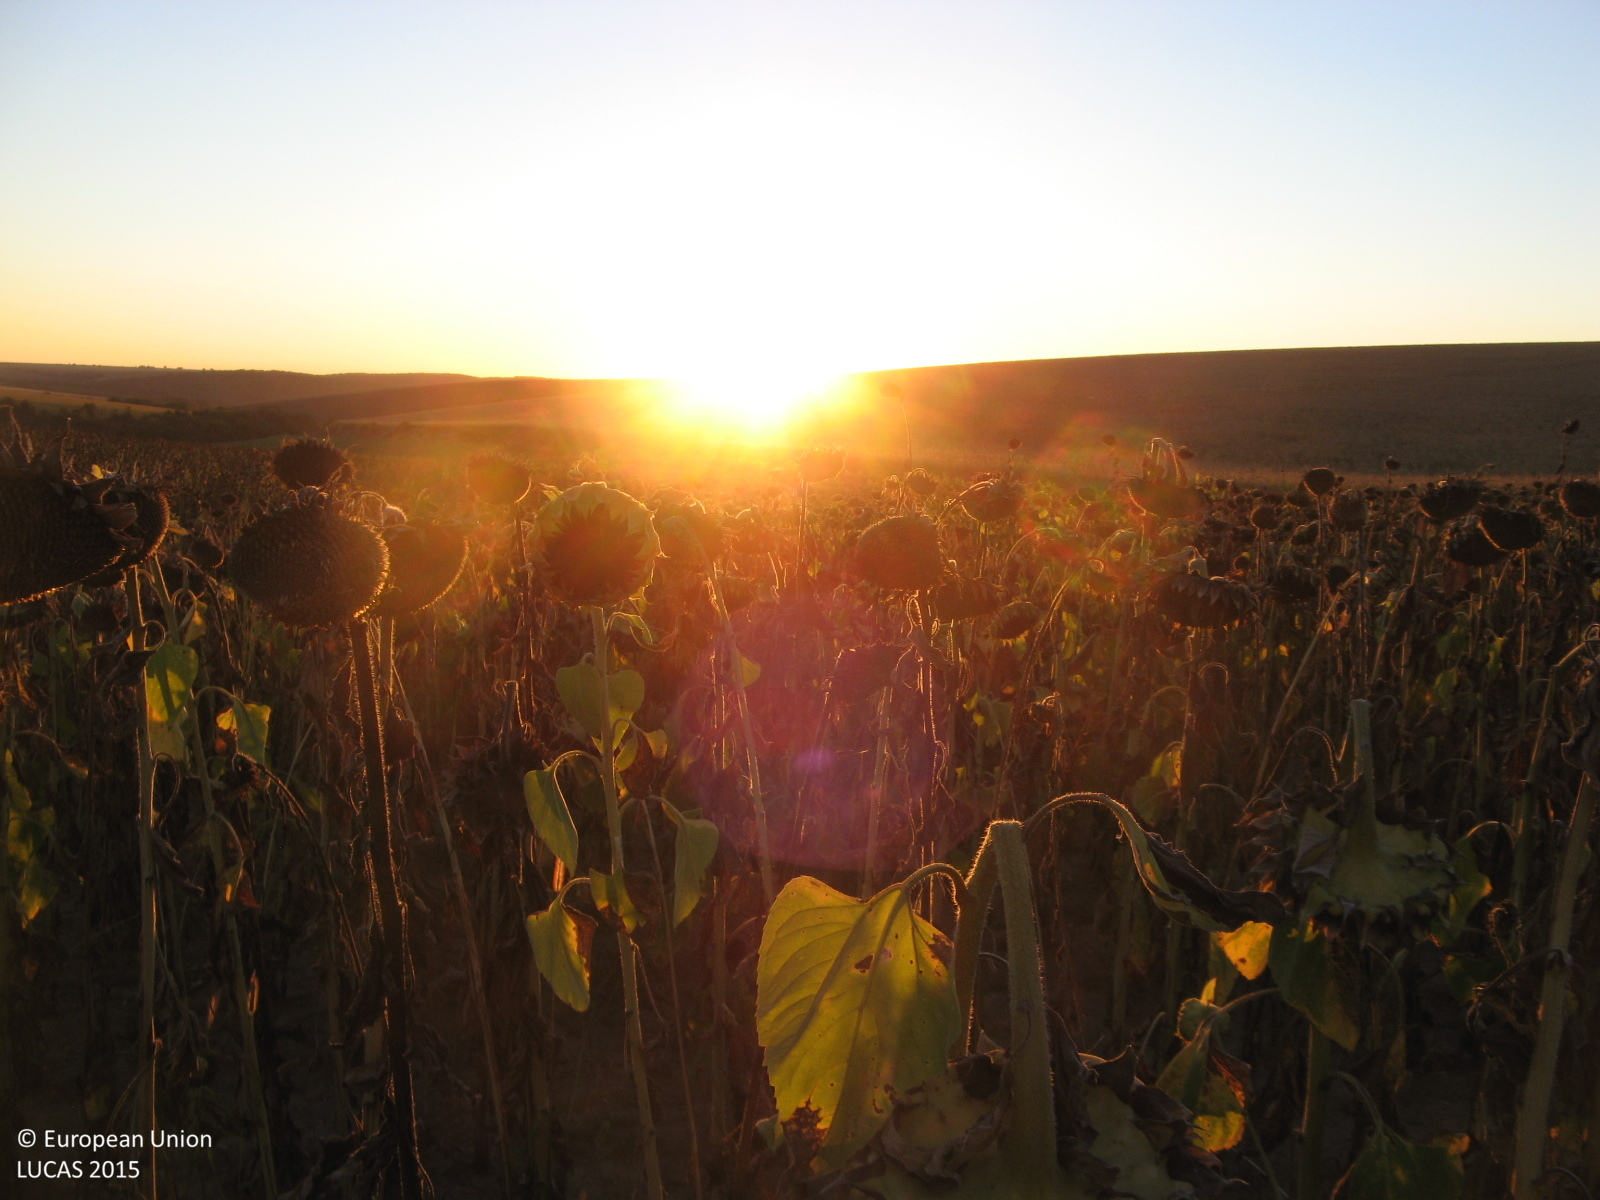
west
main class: Cropland
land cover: Sunflower
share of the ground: > 75 %
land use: Agriculture (excluding fallow land and kitchen gardens)
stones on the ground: < 10 %
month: September
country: BG
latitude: 43.5681
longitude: 26.0543
